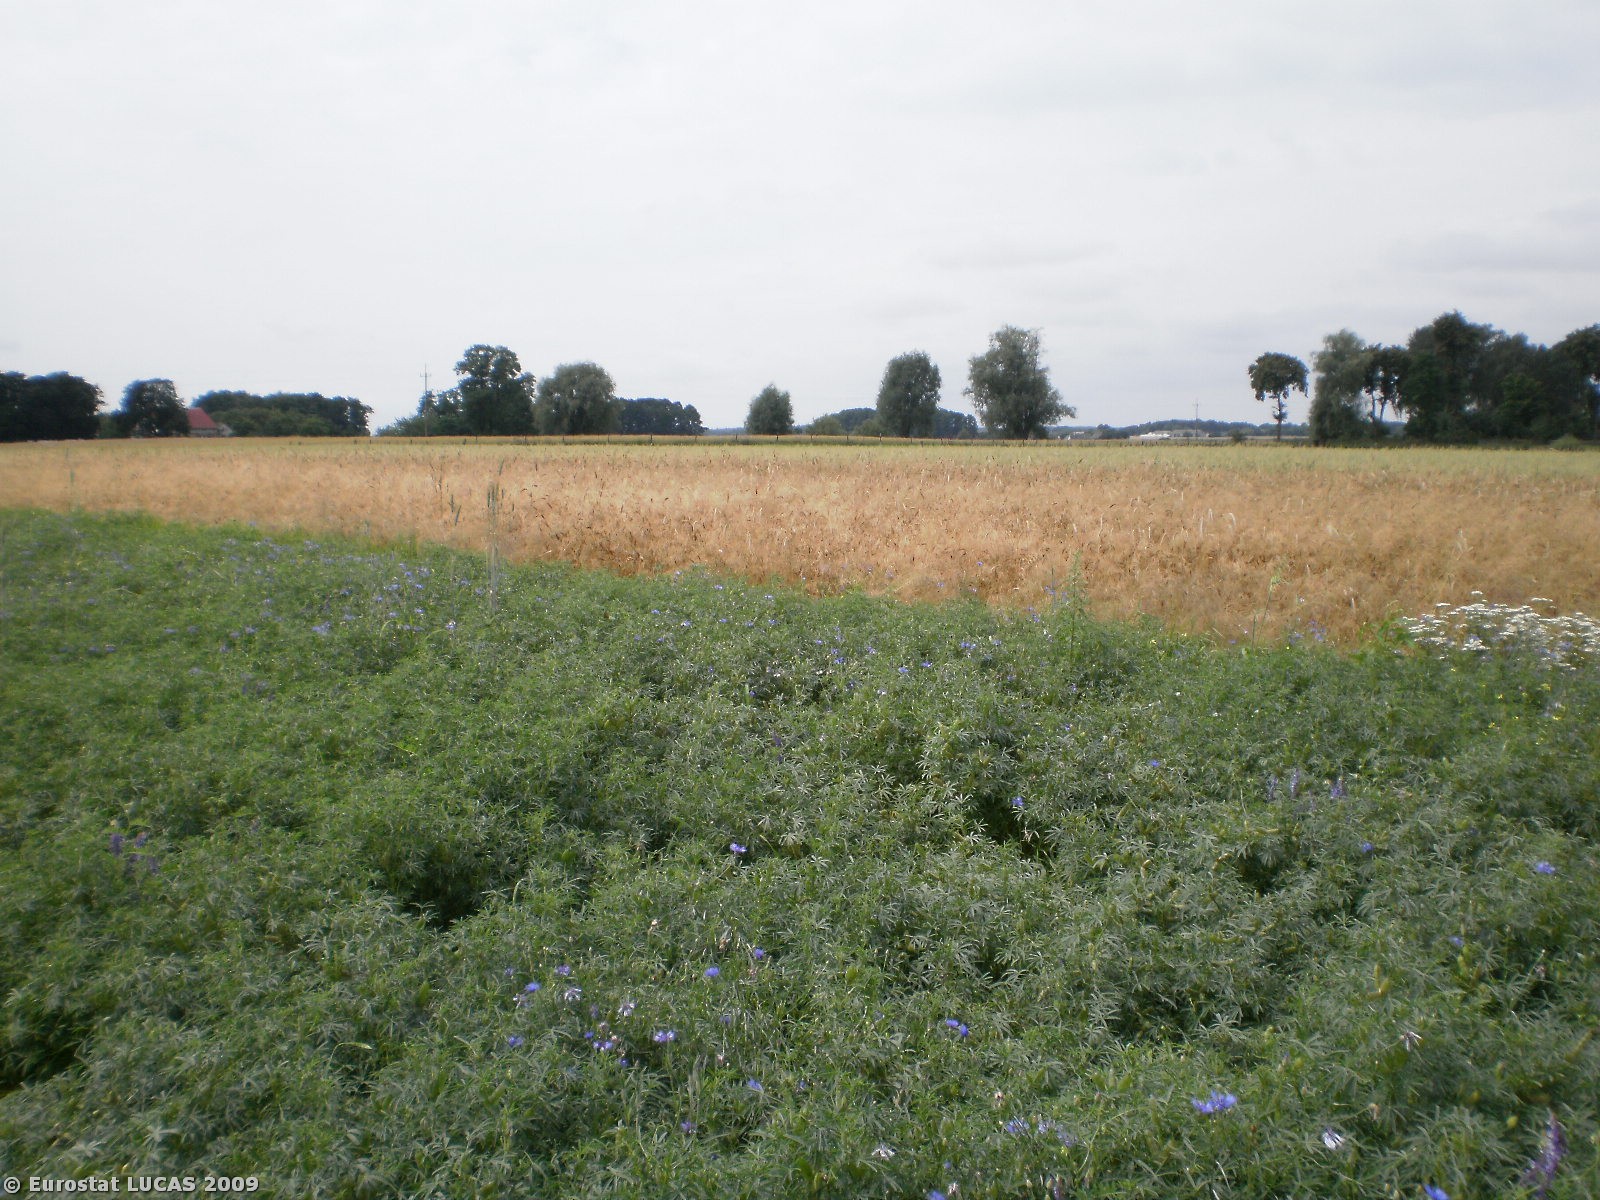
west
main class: Cropland
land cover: Dry pulses
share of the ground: > 75 %
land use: Agriculture (excluding fallow land and kitchen gardens)
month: July
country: PL
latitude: 52.6153
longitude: 20.9284
